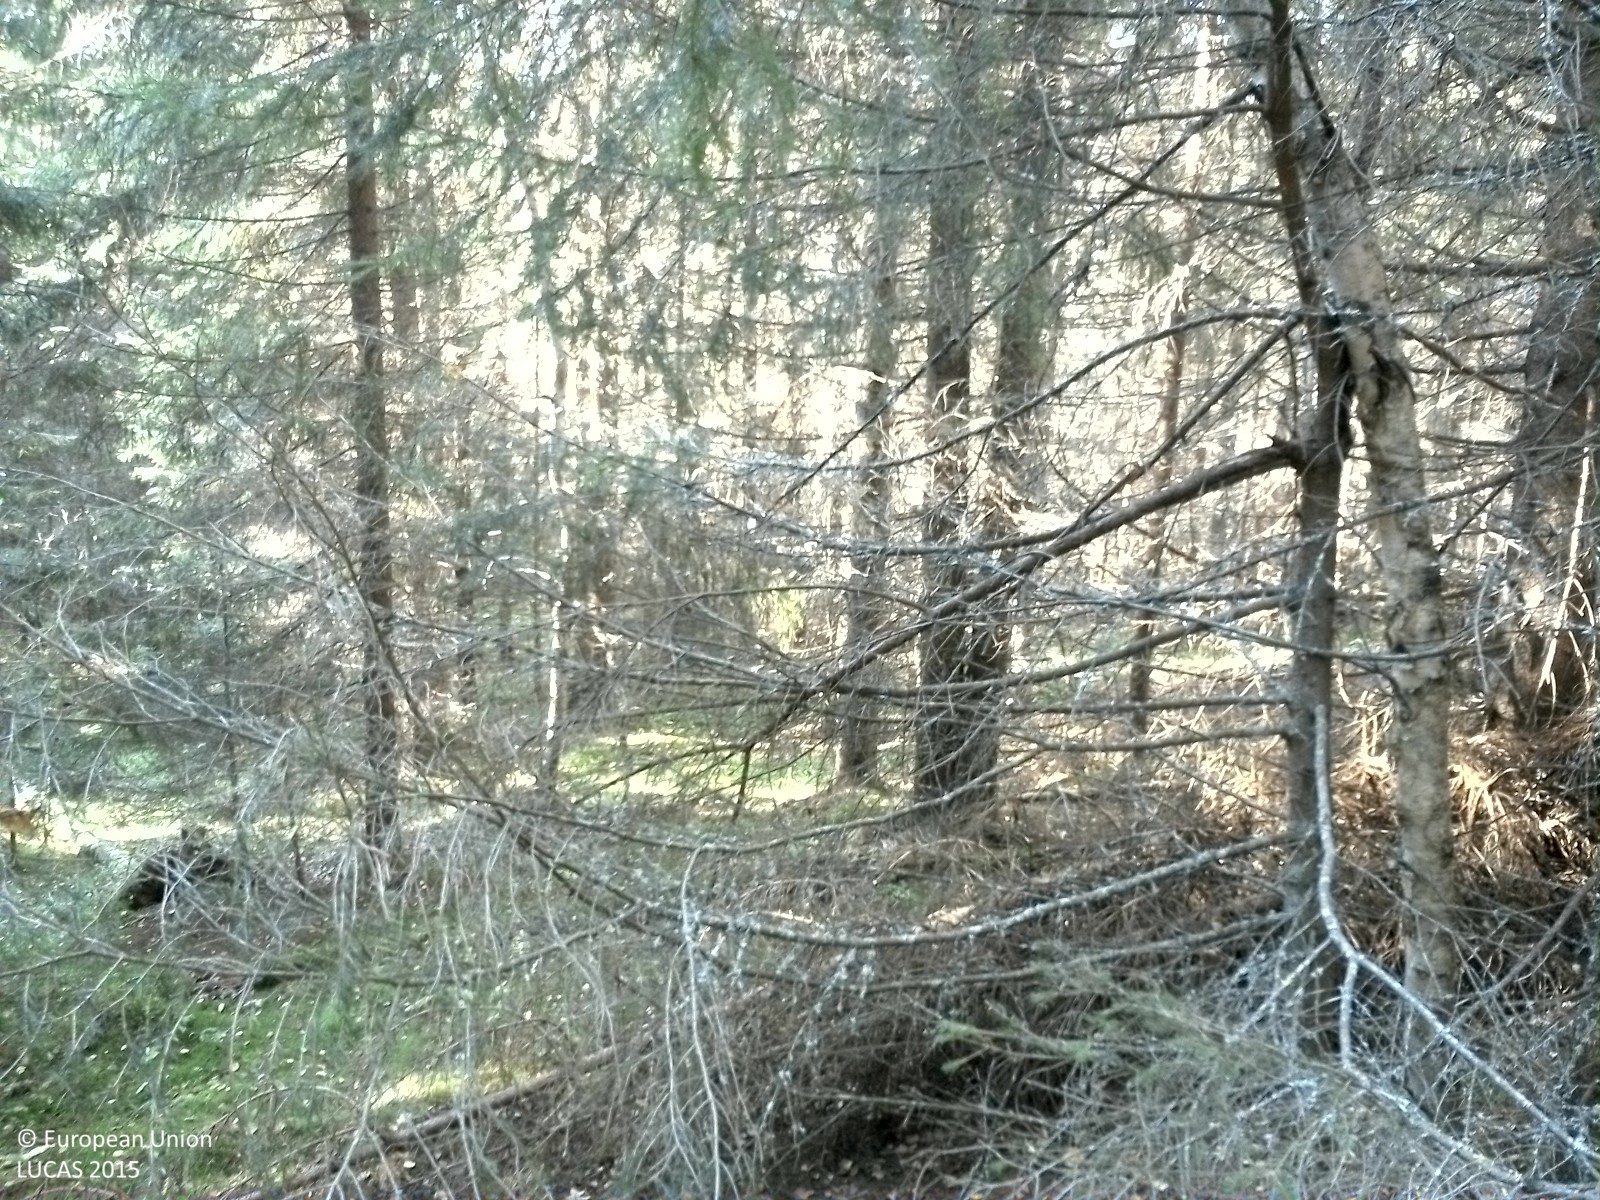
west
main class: Woodland
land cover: Spruce dominated coniferous woodland
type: boreal forest
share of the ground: > 75 %
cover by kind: coniferous forest trees 80 %, broadleaved forest trees 10 %, shrubs 10 %
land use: Forestry
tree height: > 5 m
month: September
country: SE
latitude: 62.2946
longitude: 17.2109
